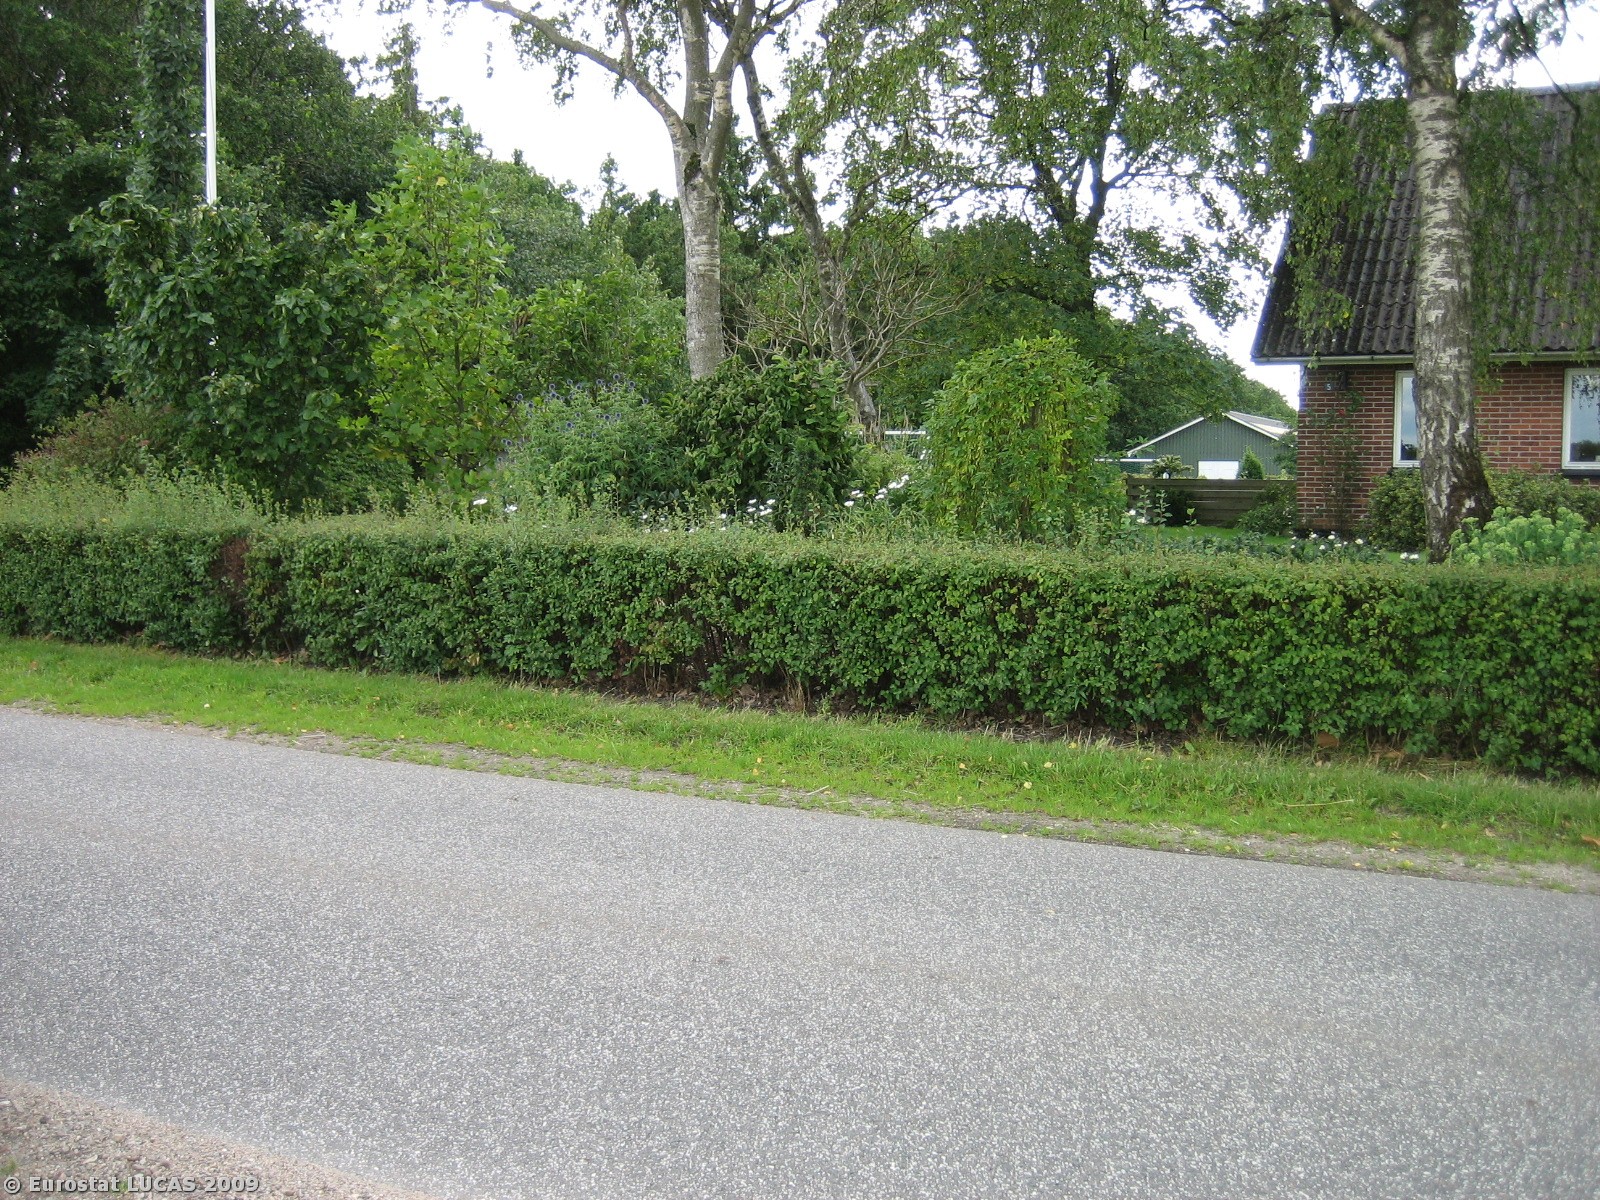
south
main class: Cropland
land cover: Barley
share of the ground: > 75 %
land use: Agriculture (excluding fallow land and kitchen gardens)
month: July
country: DK
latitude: 55.7883
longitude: 8.9963
